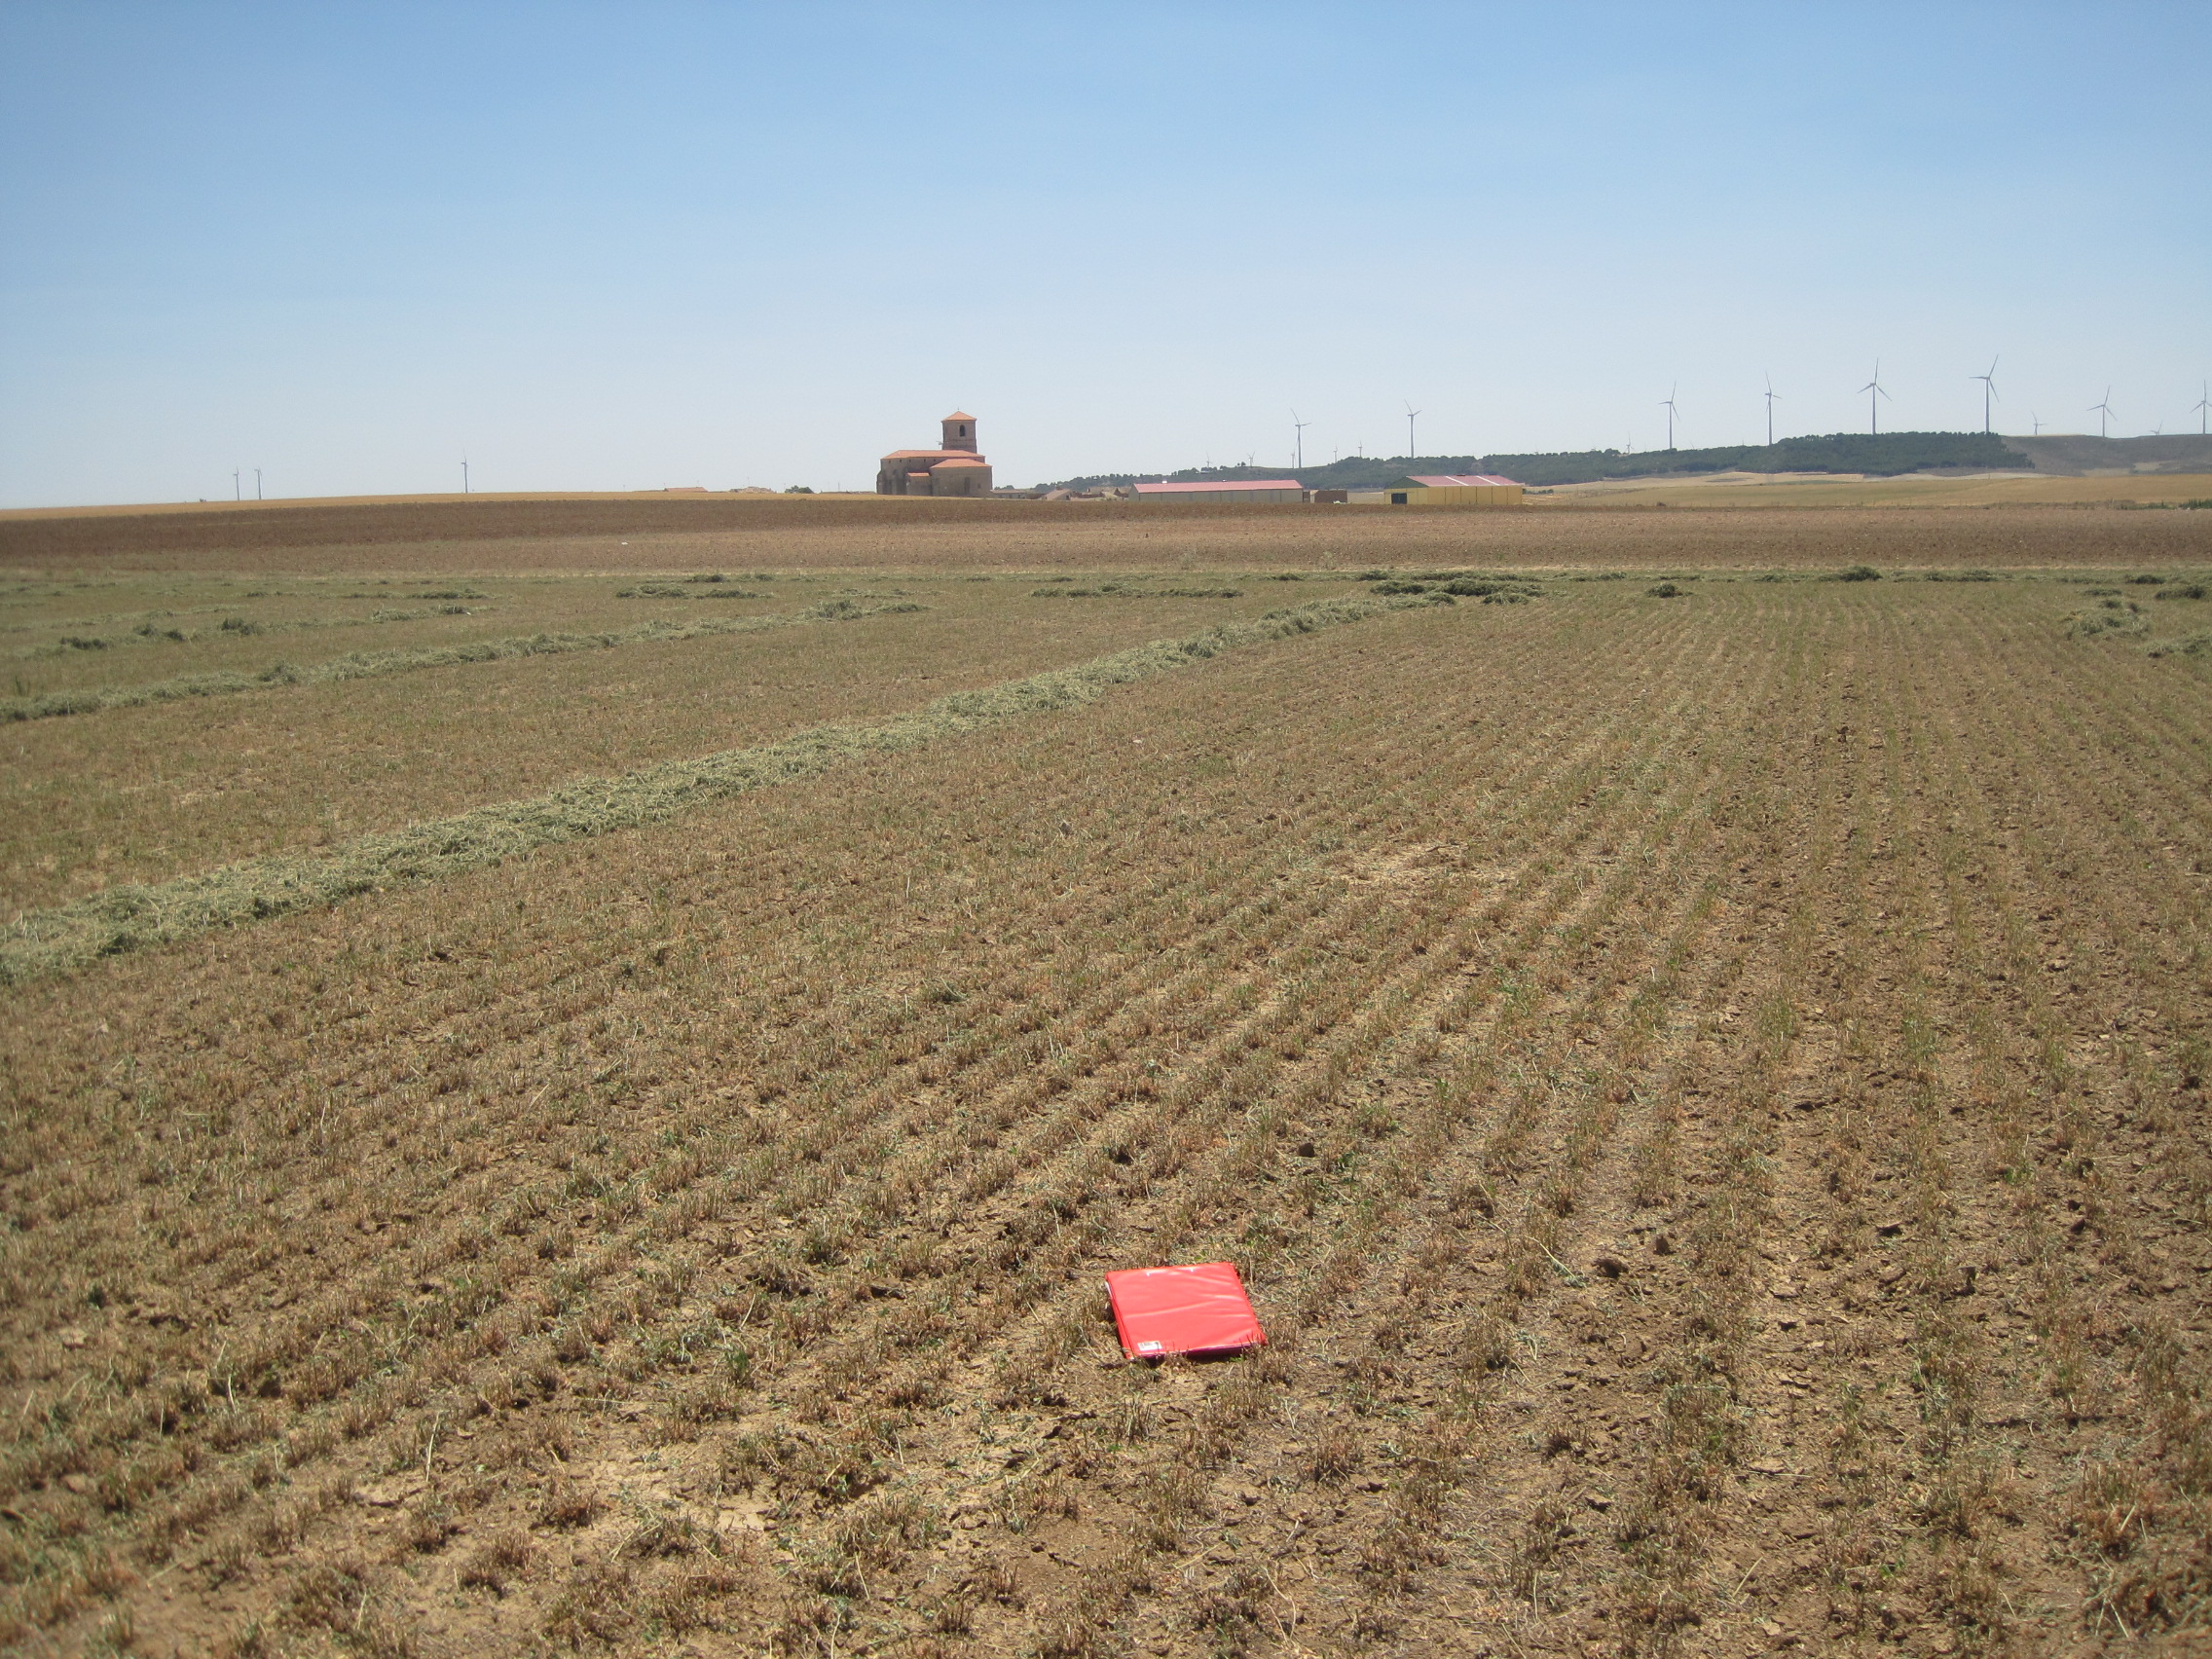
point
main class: Cropland
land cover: Lucerne
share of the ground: < 10 %
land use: Agriculture (excluding fallow land and kitchen gardens)
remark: Harvested field
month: July
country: ES
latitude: 41.9904
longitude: -4.7398
